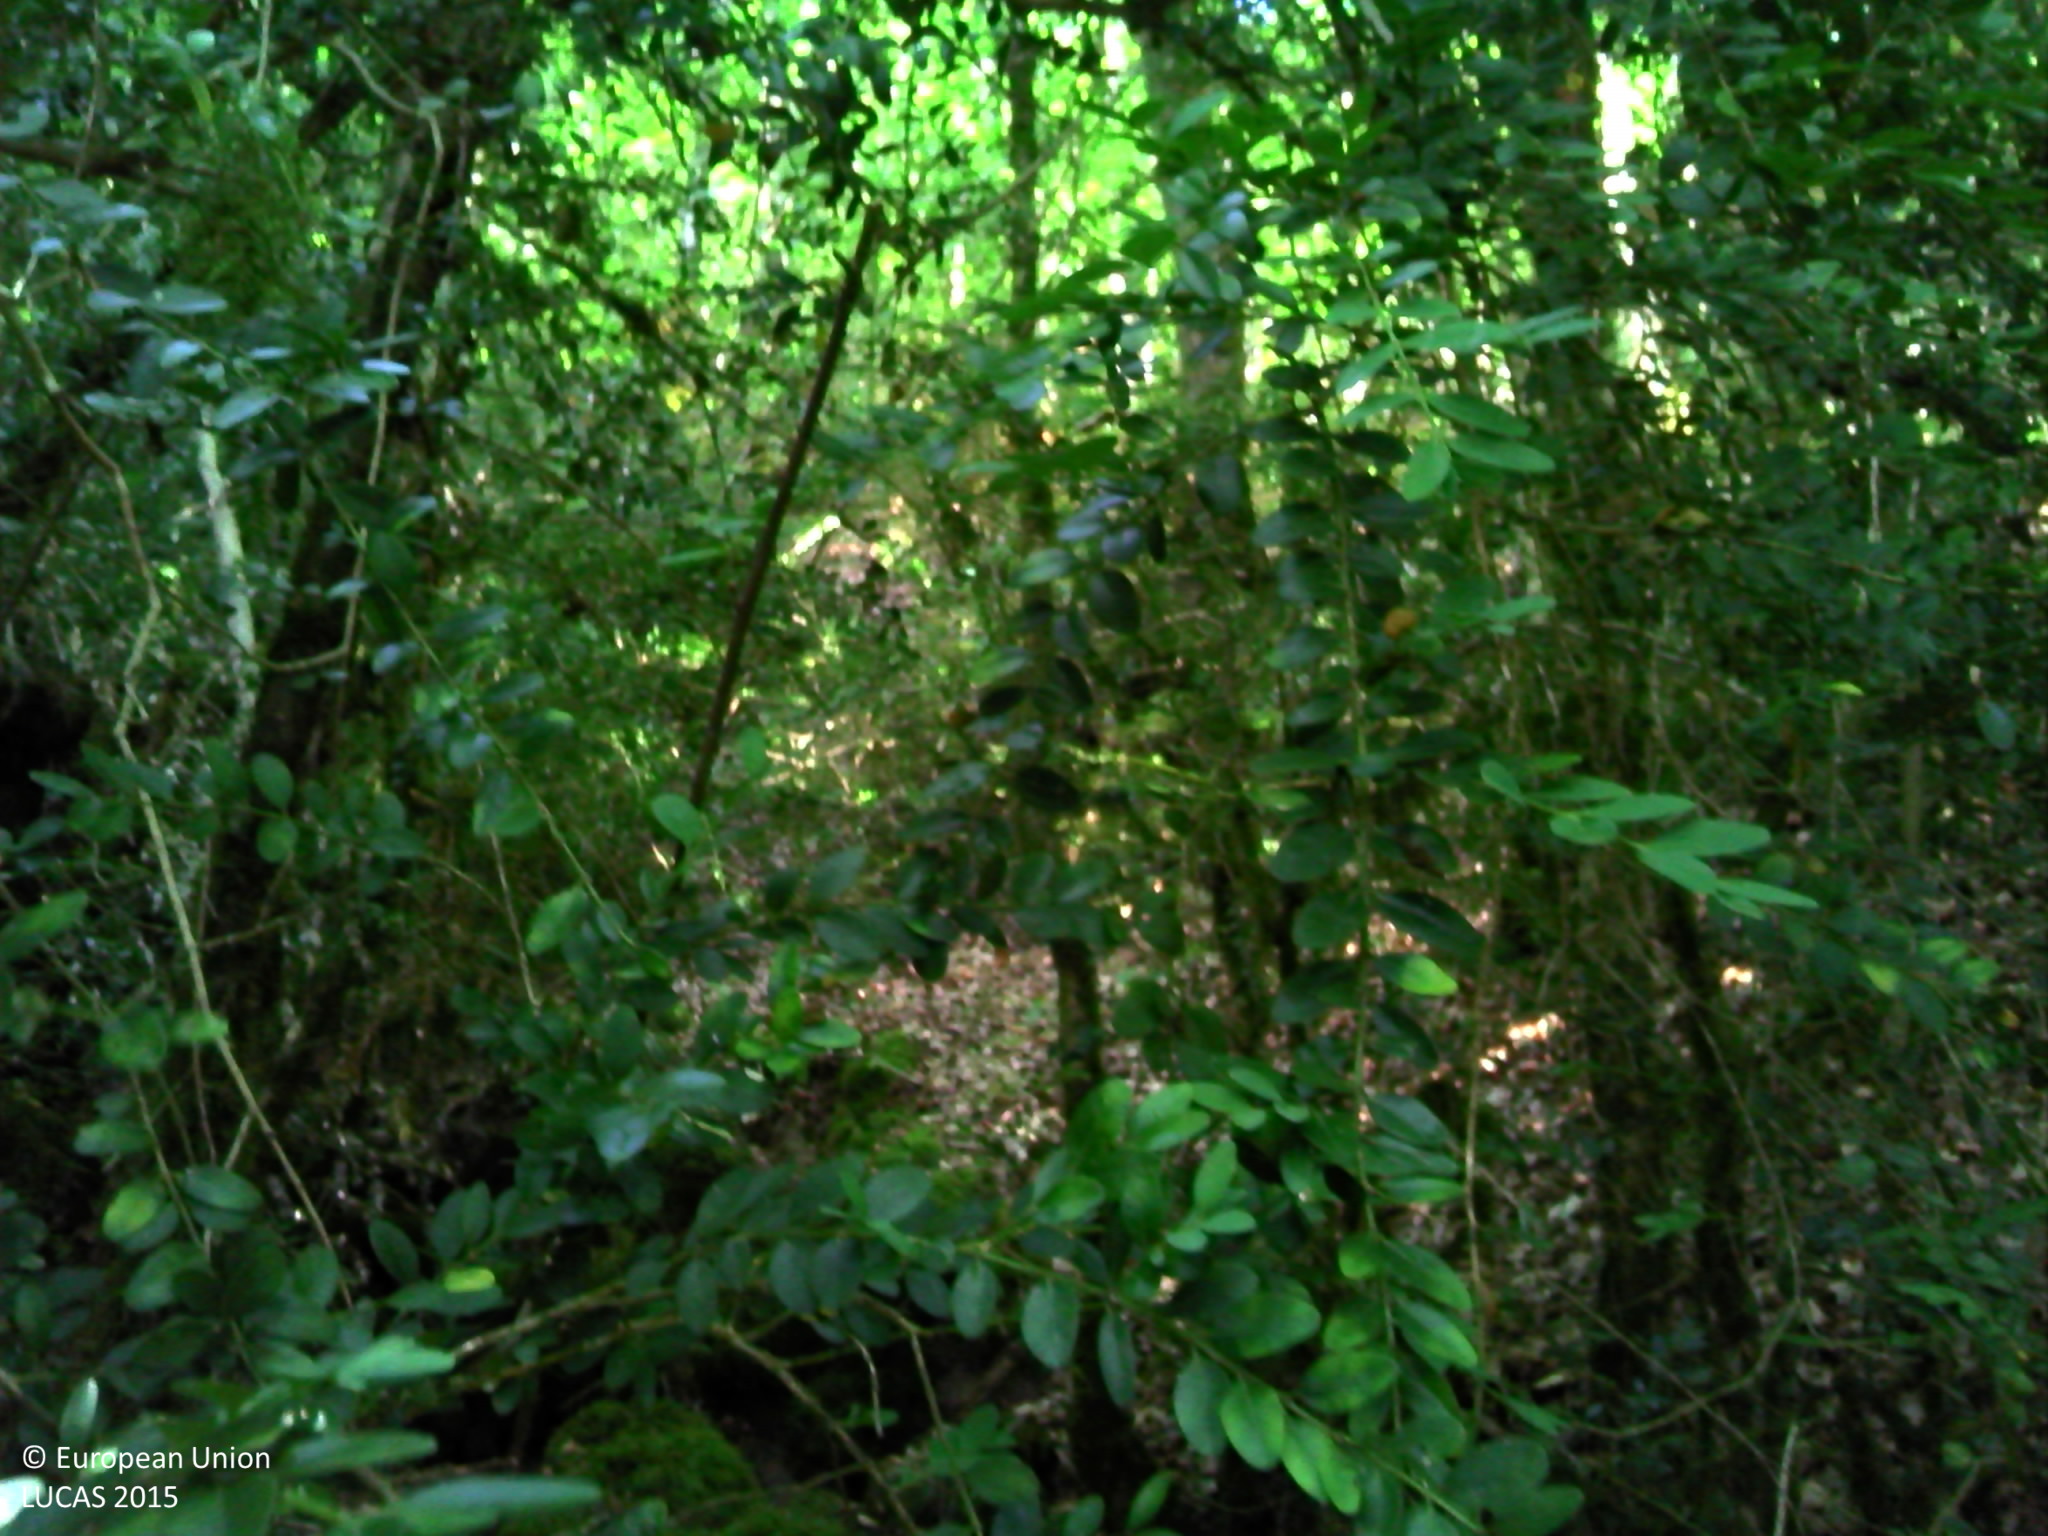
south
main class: Woodland
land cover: Broadleaved woodland
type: beech forest
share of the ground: > 75 %
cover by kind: broadleaved forest trees 80 %, herbaceous plants 10 %, shrubs 5 %, lichens and mosses 5 %
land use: Forestry
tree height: > 5 m
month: August
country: FR
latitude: 43.8674
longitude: 3.1009
